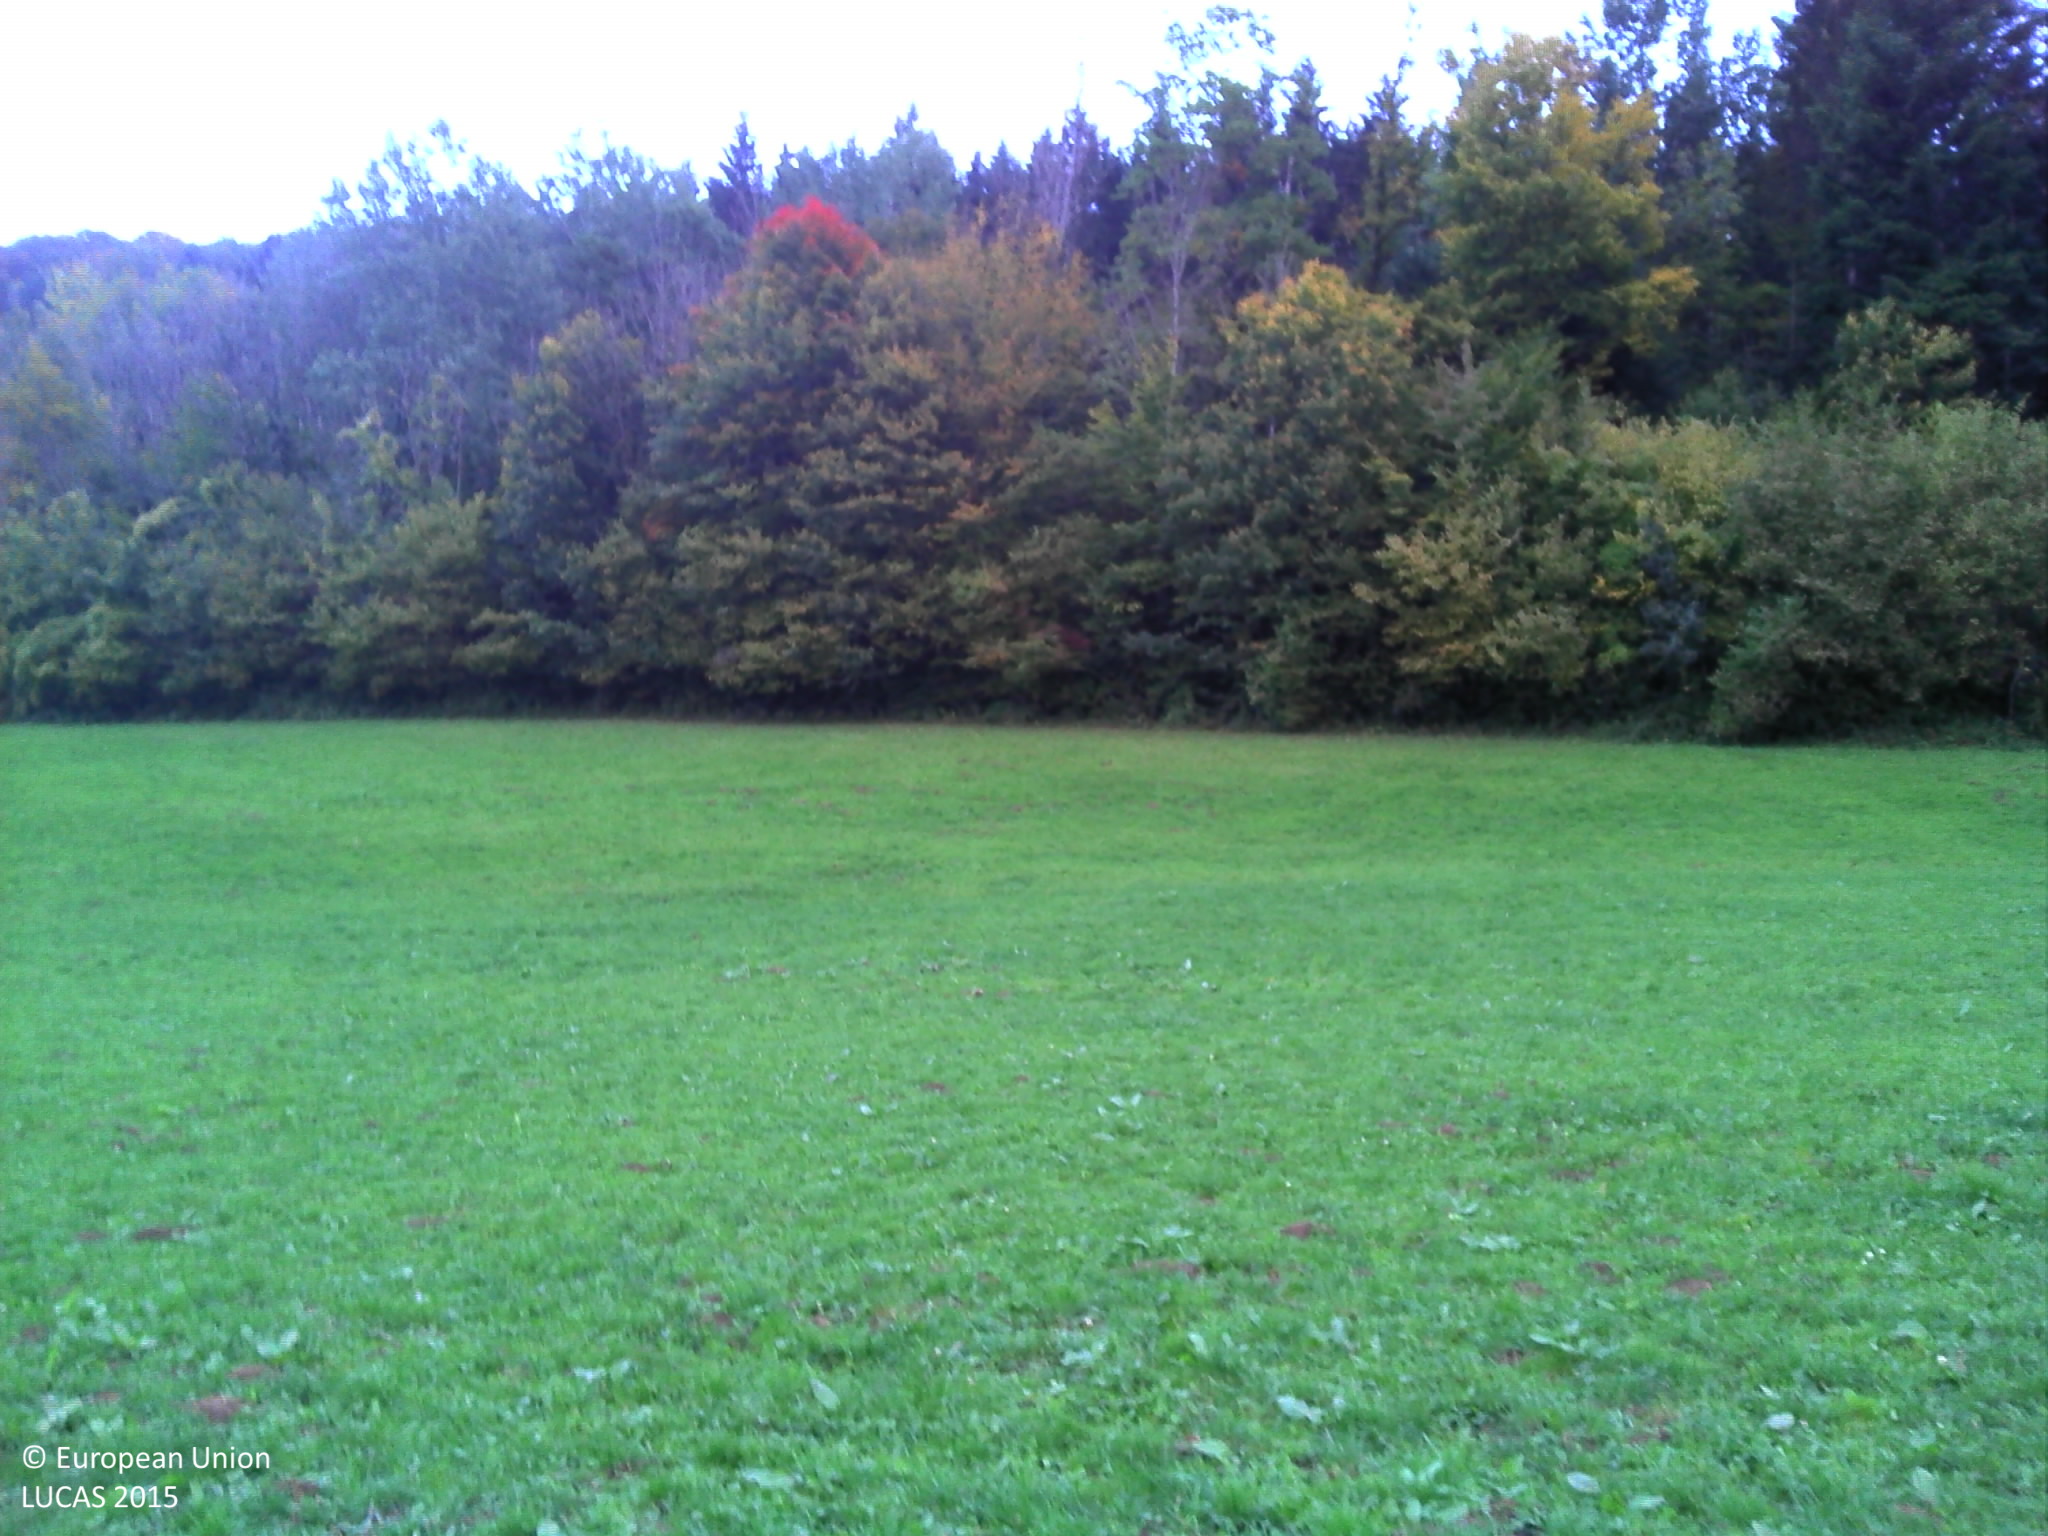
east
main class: Grassland
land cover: Grassland without tree/shrub cover
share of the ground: > 75 %
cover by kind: herbaceous plants 100 %
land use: Agriculture (excluding fallow land and kitchen gardens)
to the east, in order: Grassland without tree/shrub cover; Fences; Broadleaved woodland; Tracks; Broadleaved woodland; Spruce dominated coniferous woodland; Fences; Grassland without tree/shrub cover; Tracks; Fences; Spruce dominated coniferous woodland; Tracks; Spruce dominated coniferous woodland; Spruce dominated mixed woodland
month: October
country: FR
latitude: 47.0891
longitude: 6.0369
